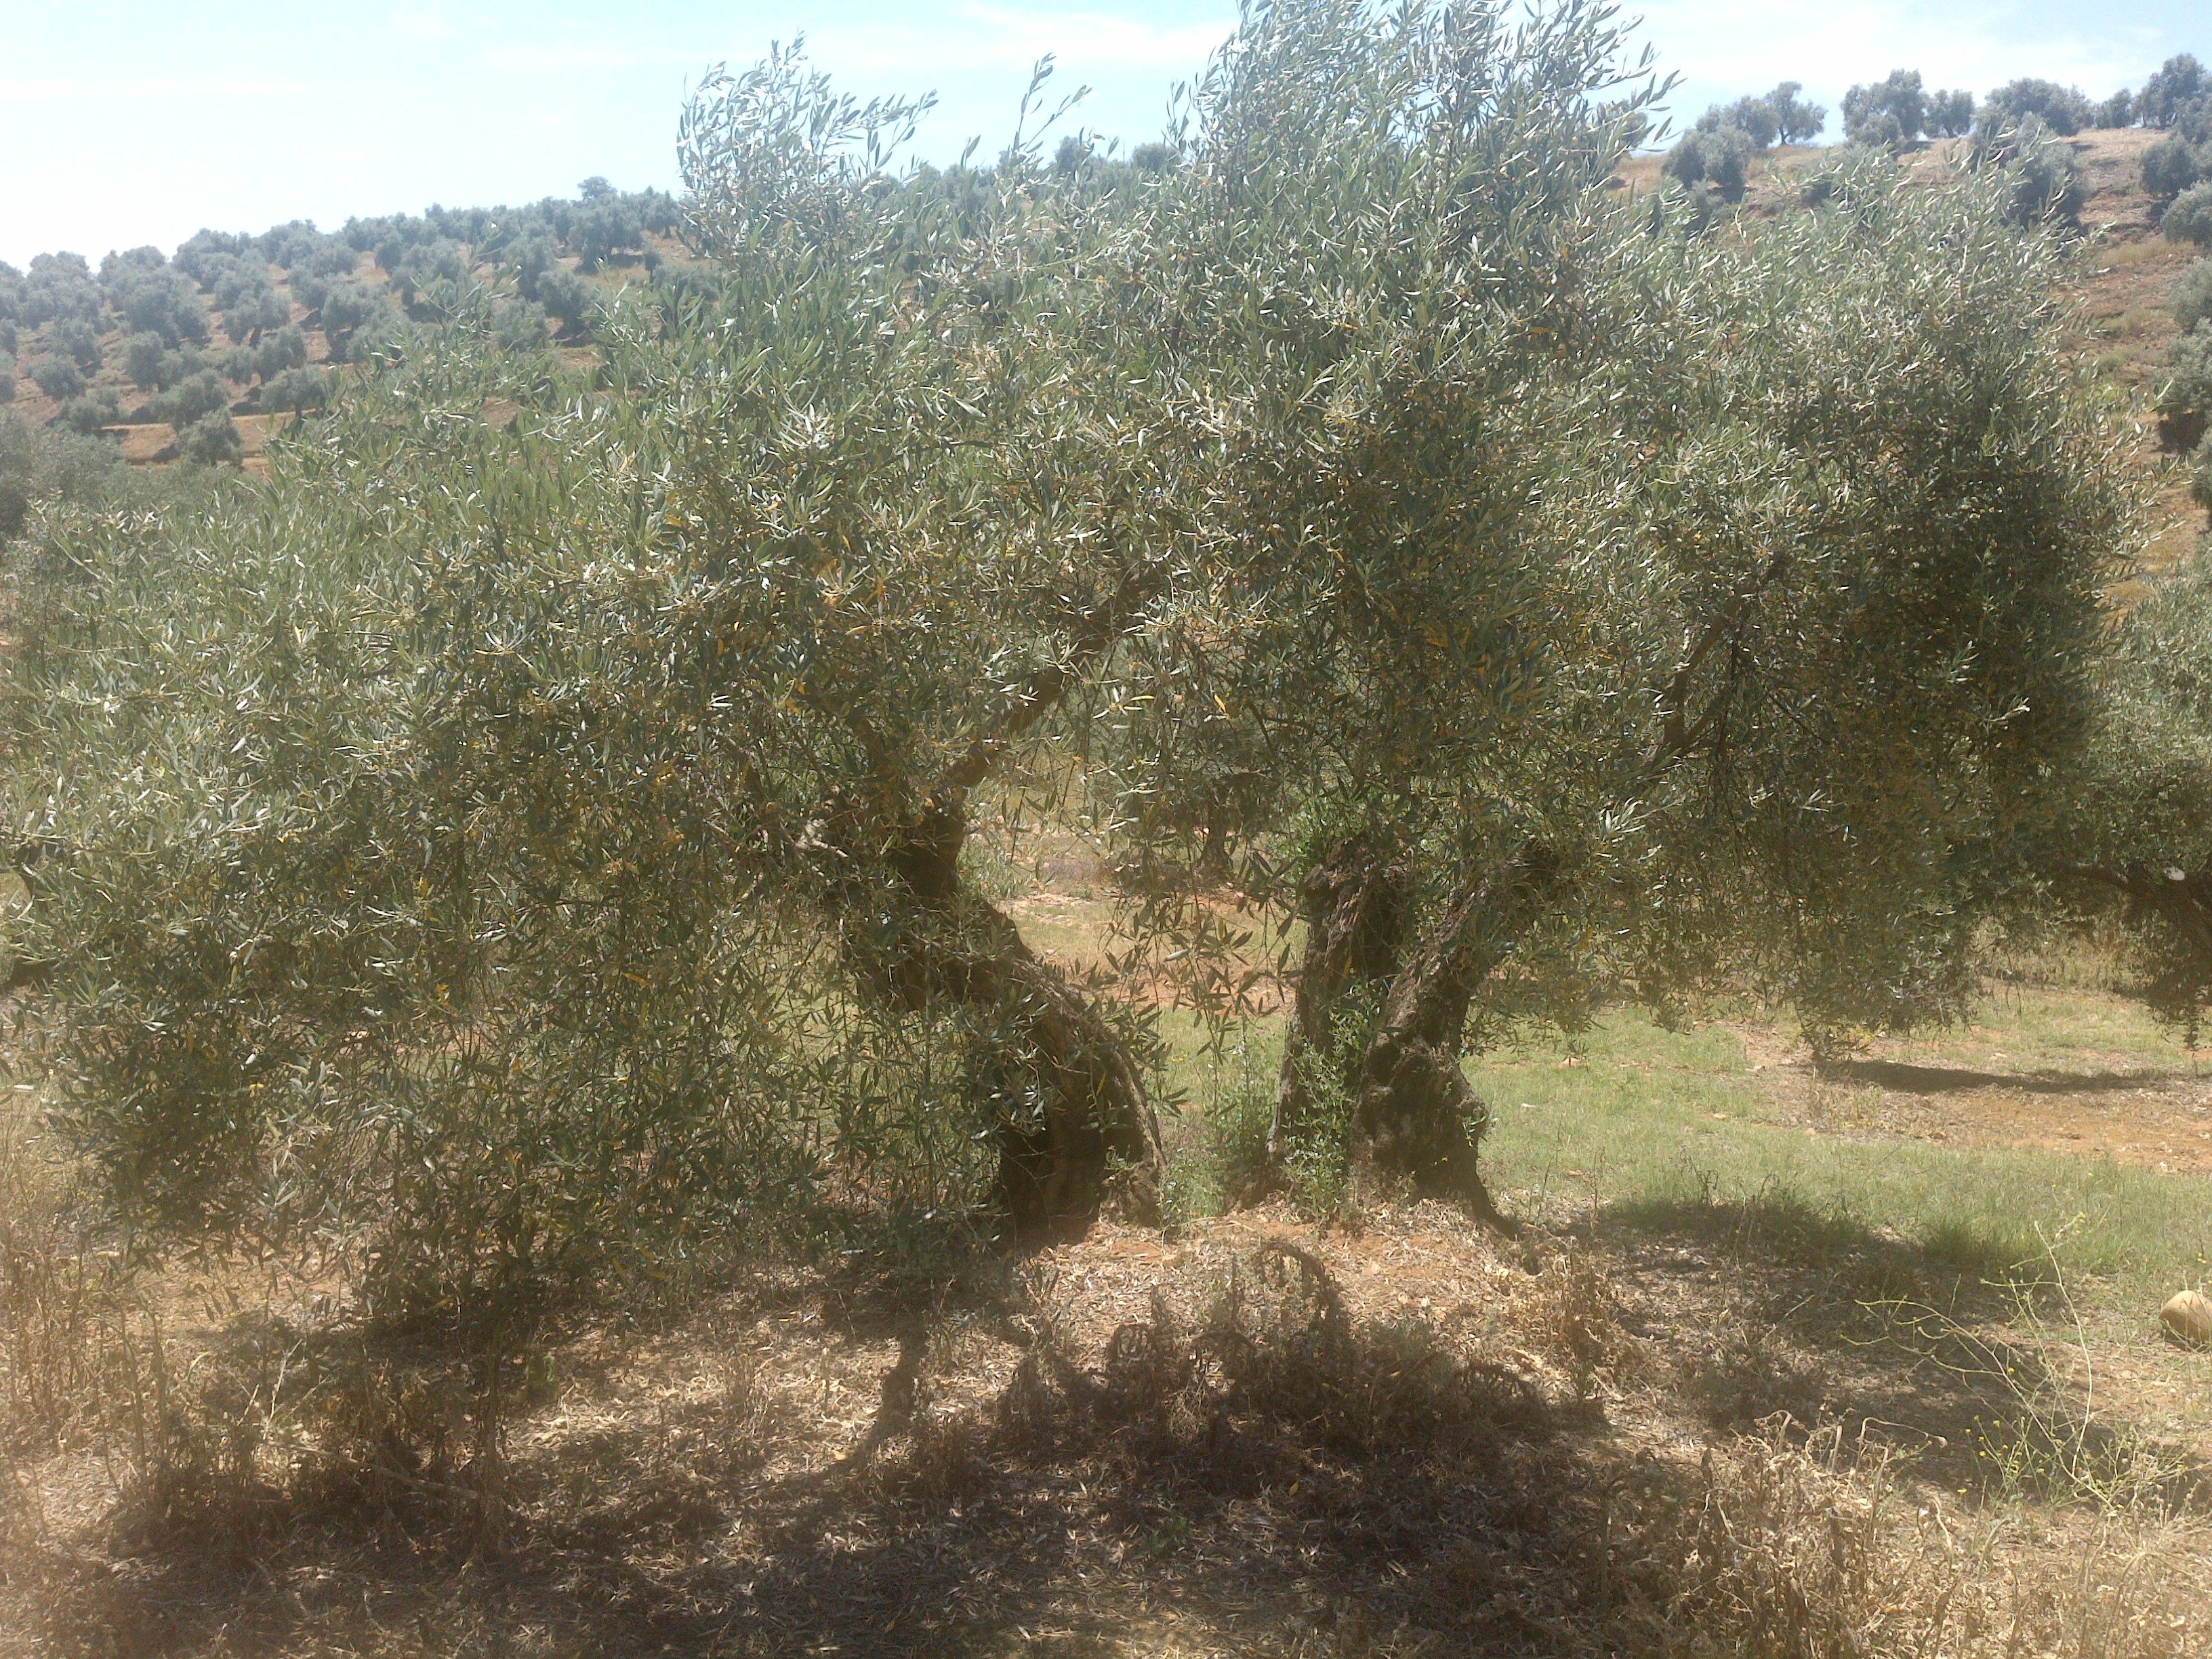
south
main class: Cropland
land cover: Olive groves
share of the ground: 25 - 50 %
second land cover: Spontaneously vegetated surfaces
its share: 10 - 25 %
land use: Agriculture (excluding fallow land and kitchen gardens)
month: May
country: ES
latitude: 38.0103
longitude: -4.4888
